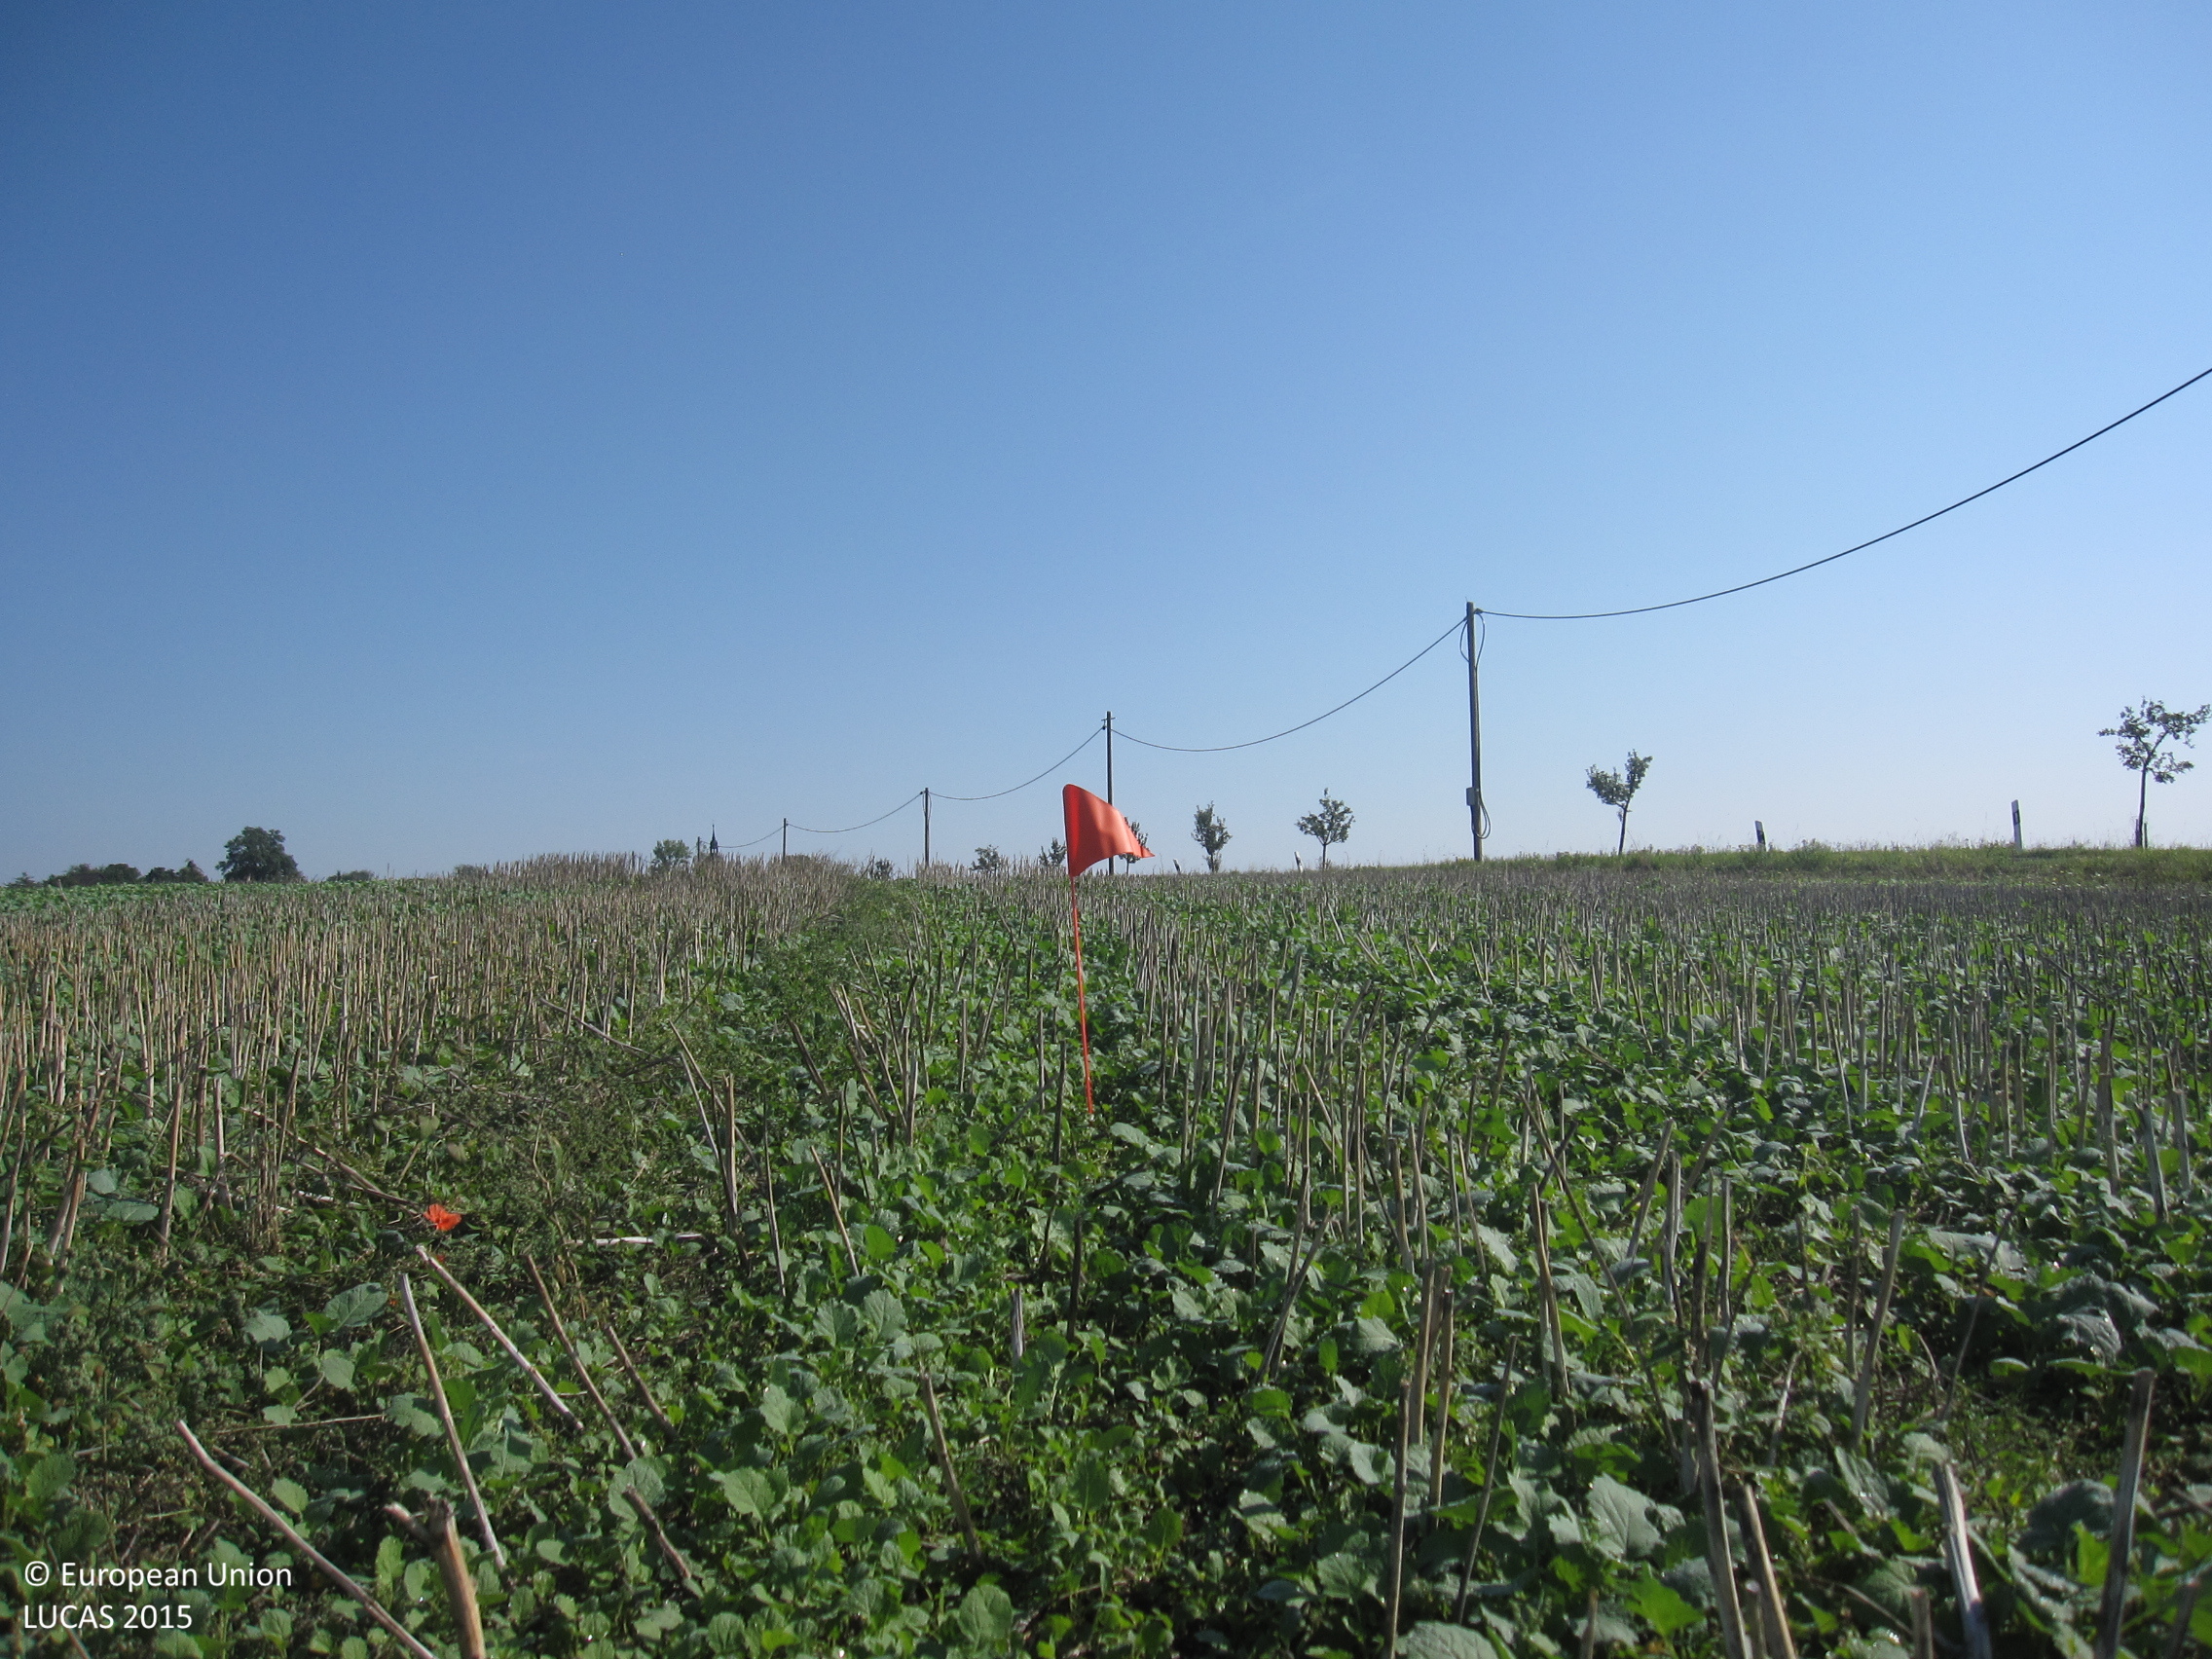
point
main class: Cropland
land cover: Rape and turnip rape
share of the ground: > 75 %
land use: Agriculture (excluding fallow land and kitchen gardens)
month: August
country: DE
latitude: 50.5867
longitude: 11.5957
